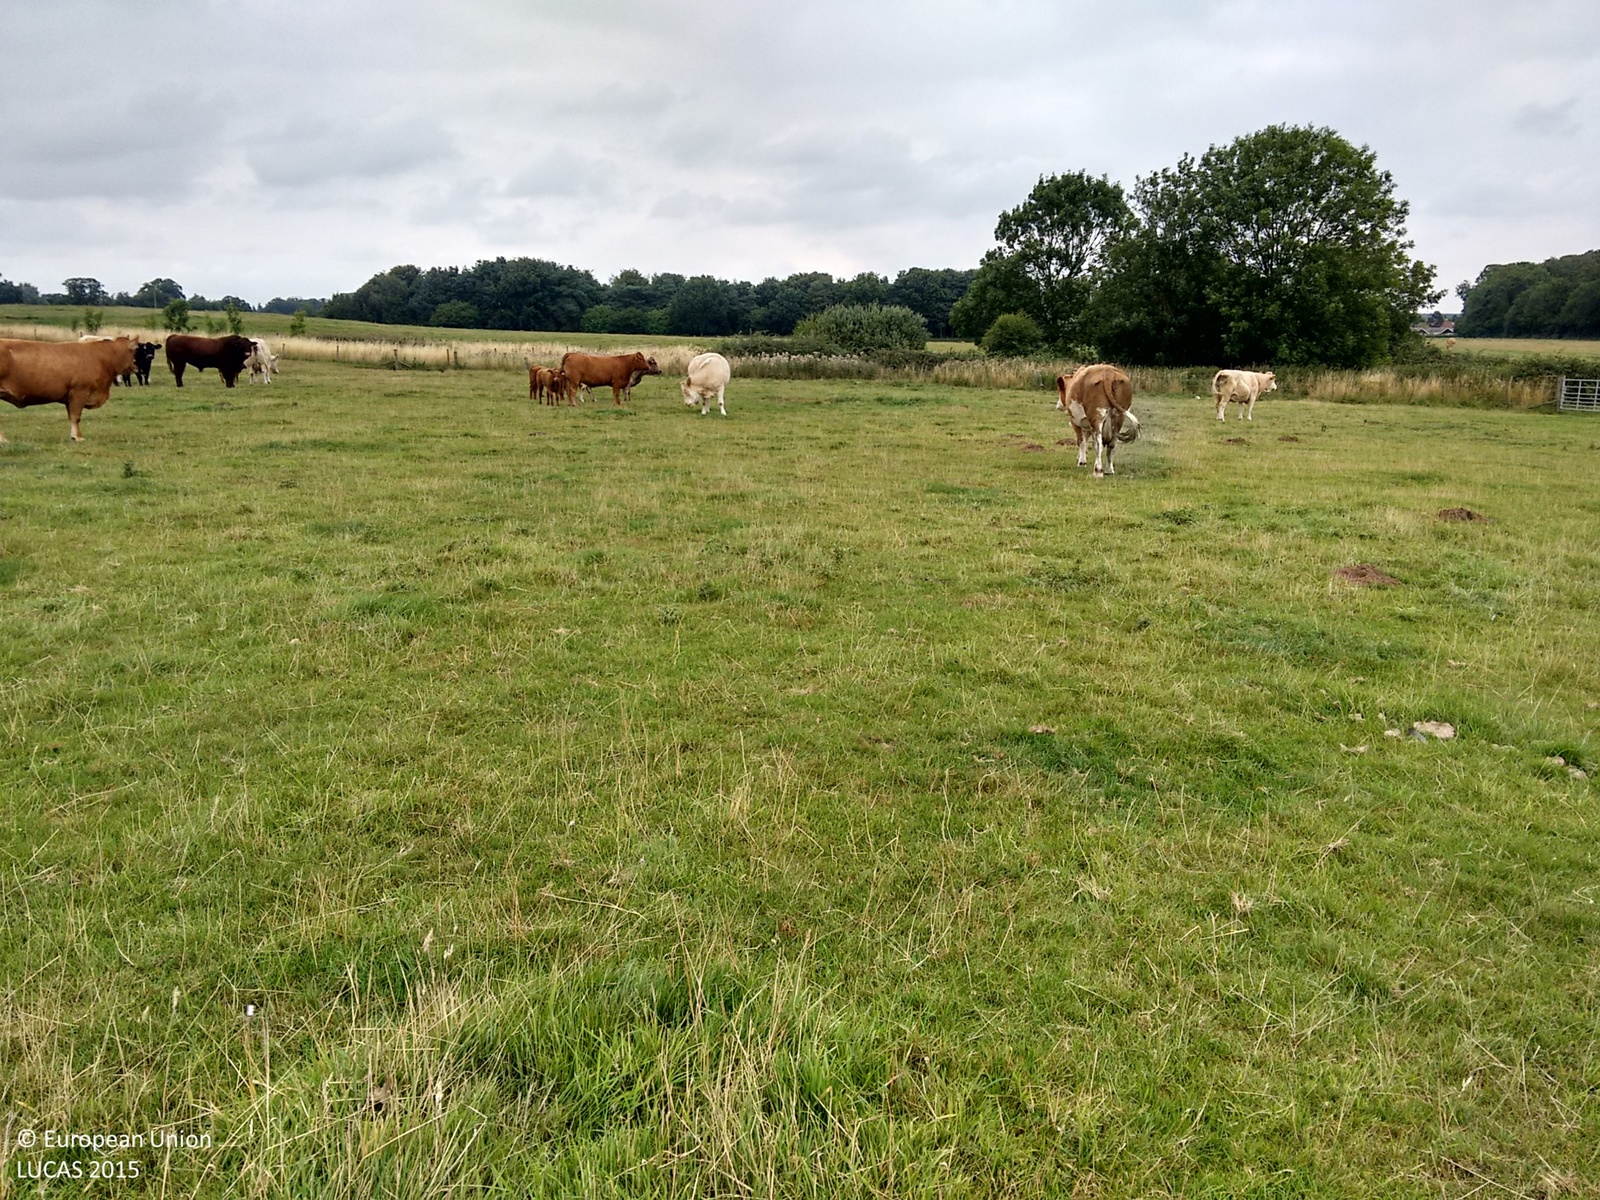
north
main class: Grassland
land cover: Grassland without tree/shrub cover
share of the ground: > 75 %
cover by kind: herbaceous plants 100 %
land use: Agriculture (excluding fallow land and kitchen gardens)
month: August
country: GB
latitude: 52.6450
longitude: 0.4690
